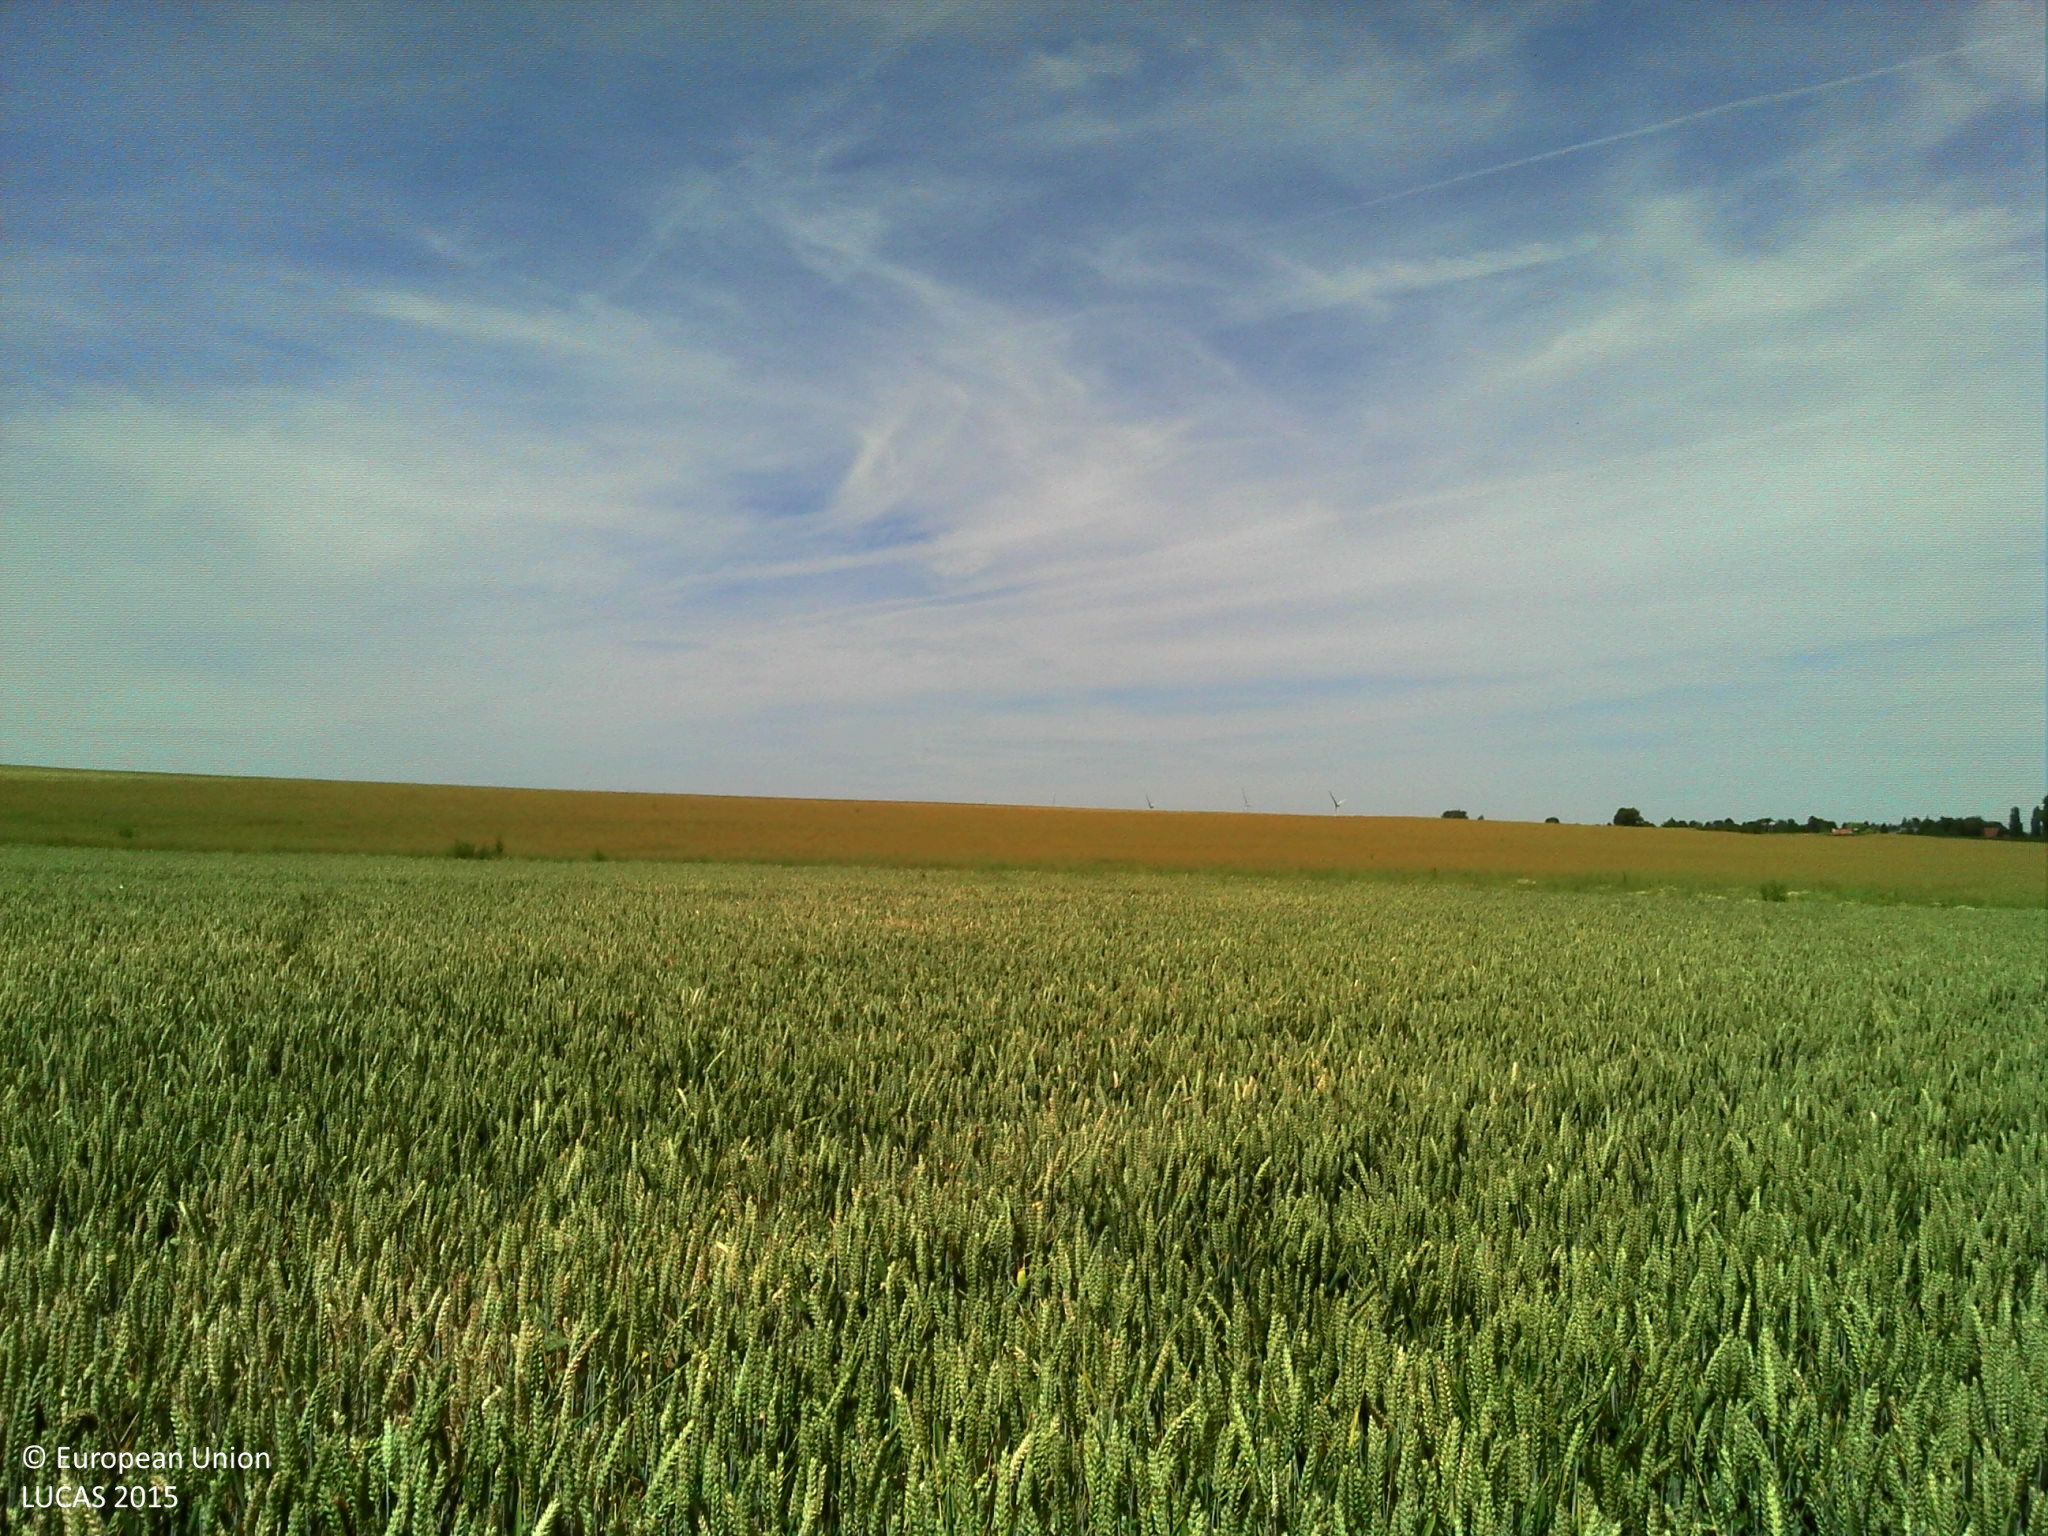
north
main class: Cropland
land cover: Common wheat
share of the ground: > 75 %
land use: Agriculture (excluding fallow land and kitchen gardens)
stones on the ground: < 10 %
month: June
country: FR
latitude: 49.5294
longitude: 2.3467
